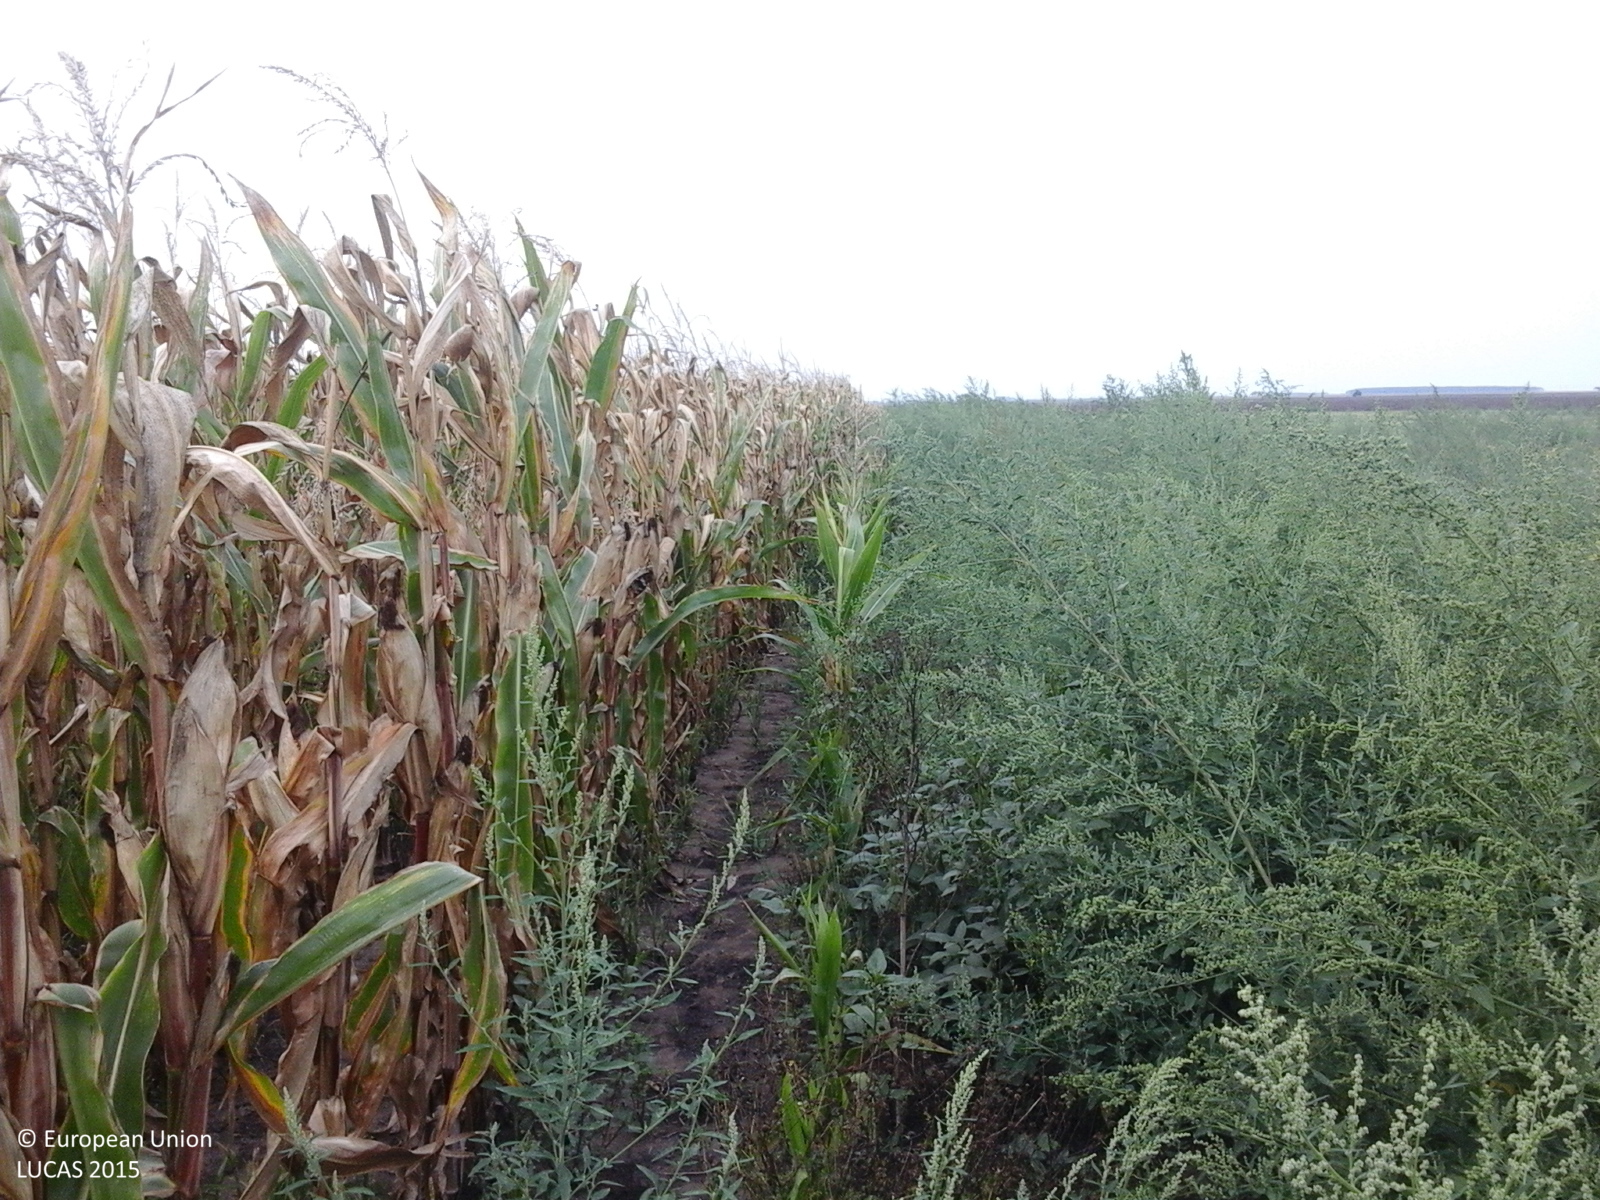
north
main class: Cropland
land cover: Maize
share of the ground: > 75 %
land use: Agriculture (excluding fallow land and kitchen gardens)
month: August
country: RO
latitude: 46.3734
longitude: 21.2533
